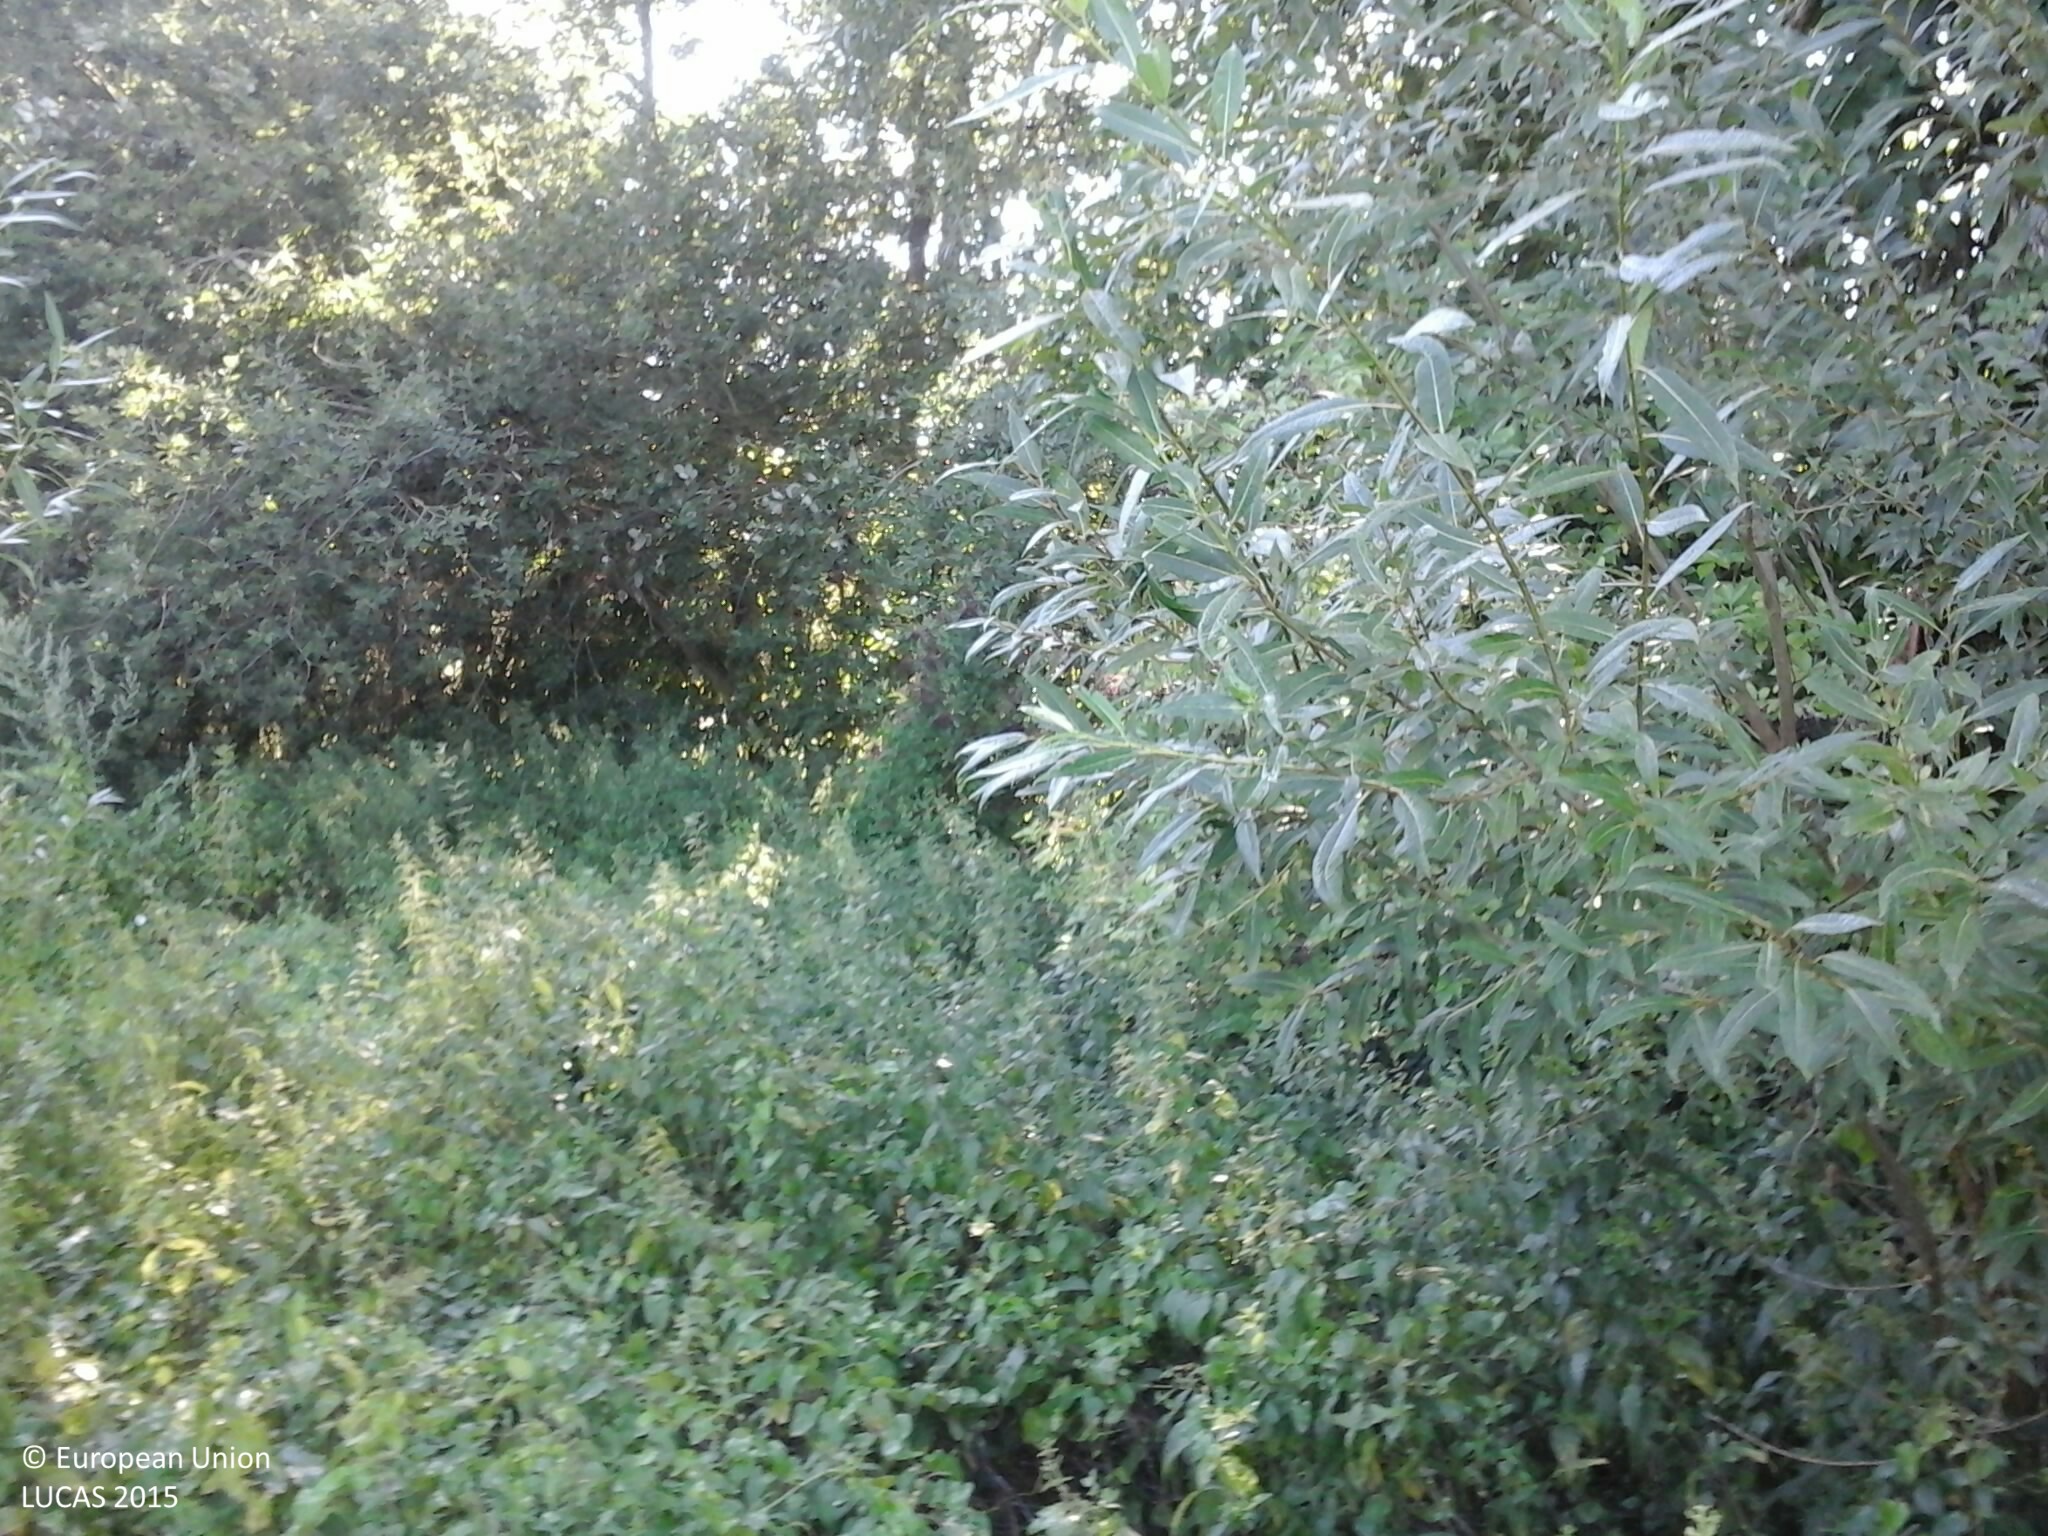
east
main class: Cropland
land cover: Maize
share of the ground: > 75 %
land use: Agriculture (excluding fallow land and kitchen gardens)
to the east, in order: Maize; Electric lines; Maize; Broadleaved woodland; Ditches and canals; Broadleaved woodland; Tracks; Common wheat; Broadleaved woodland
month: August
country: HU
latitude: 46.9579
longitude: 16.6390
